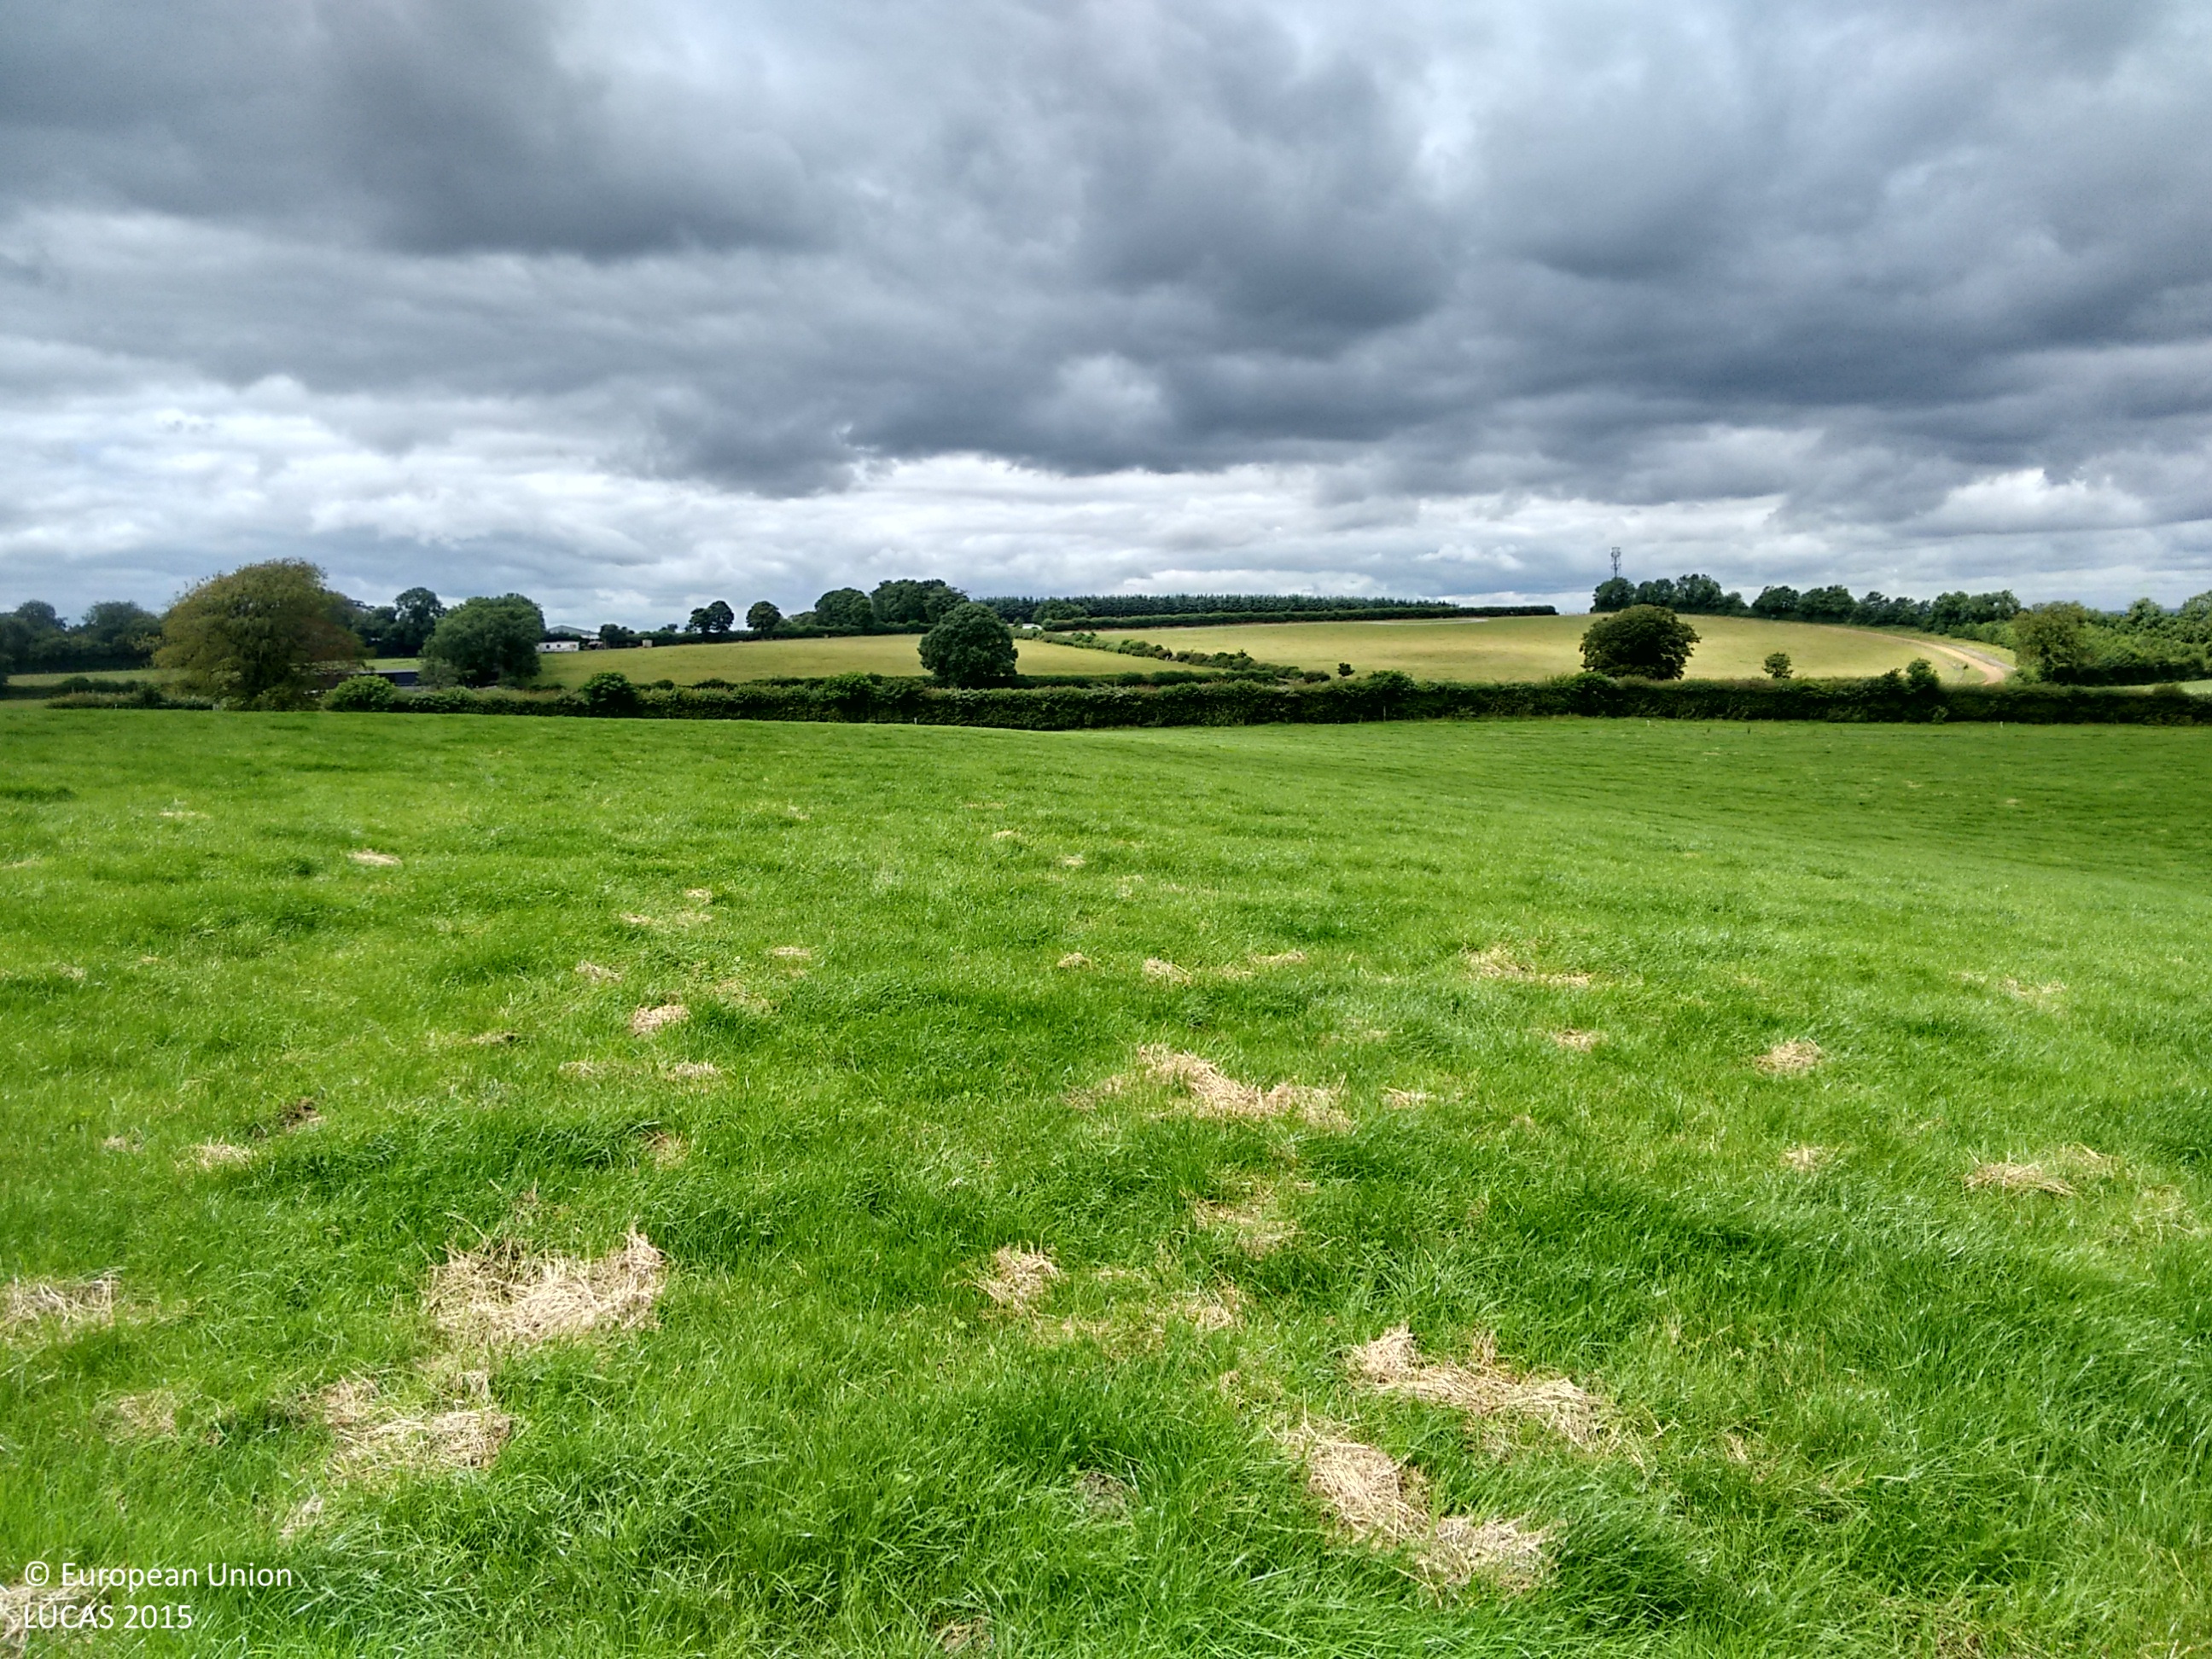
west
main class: Grassland
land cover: Grassland without tree/shrub cover
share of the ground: > 75 %
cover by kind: herbaceous plants 100 %
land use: Agriculture (excluding fallow land and kitchen gardens)
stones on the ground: < 10 %
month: July
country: IE
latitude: 52.9700
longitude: -6.7985
